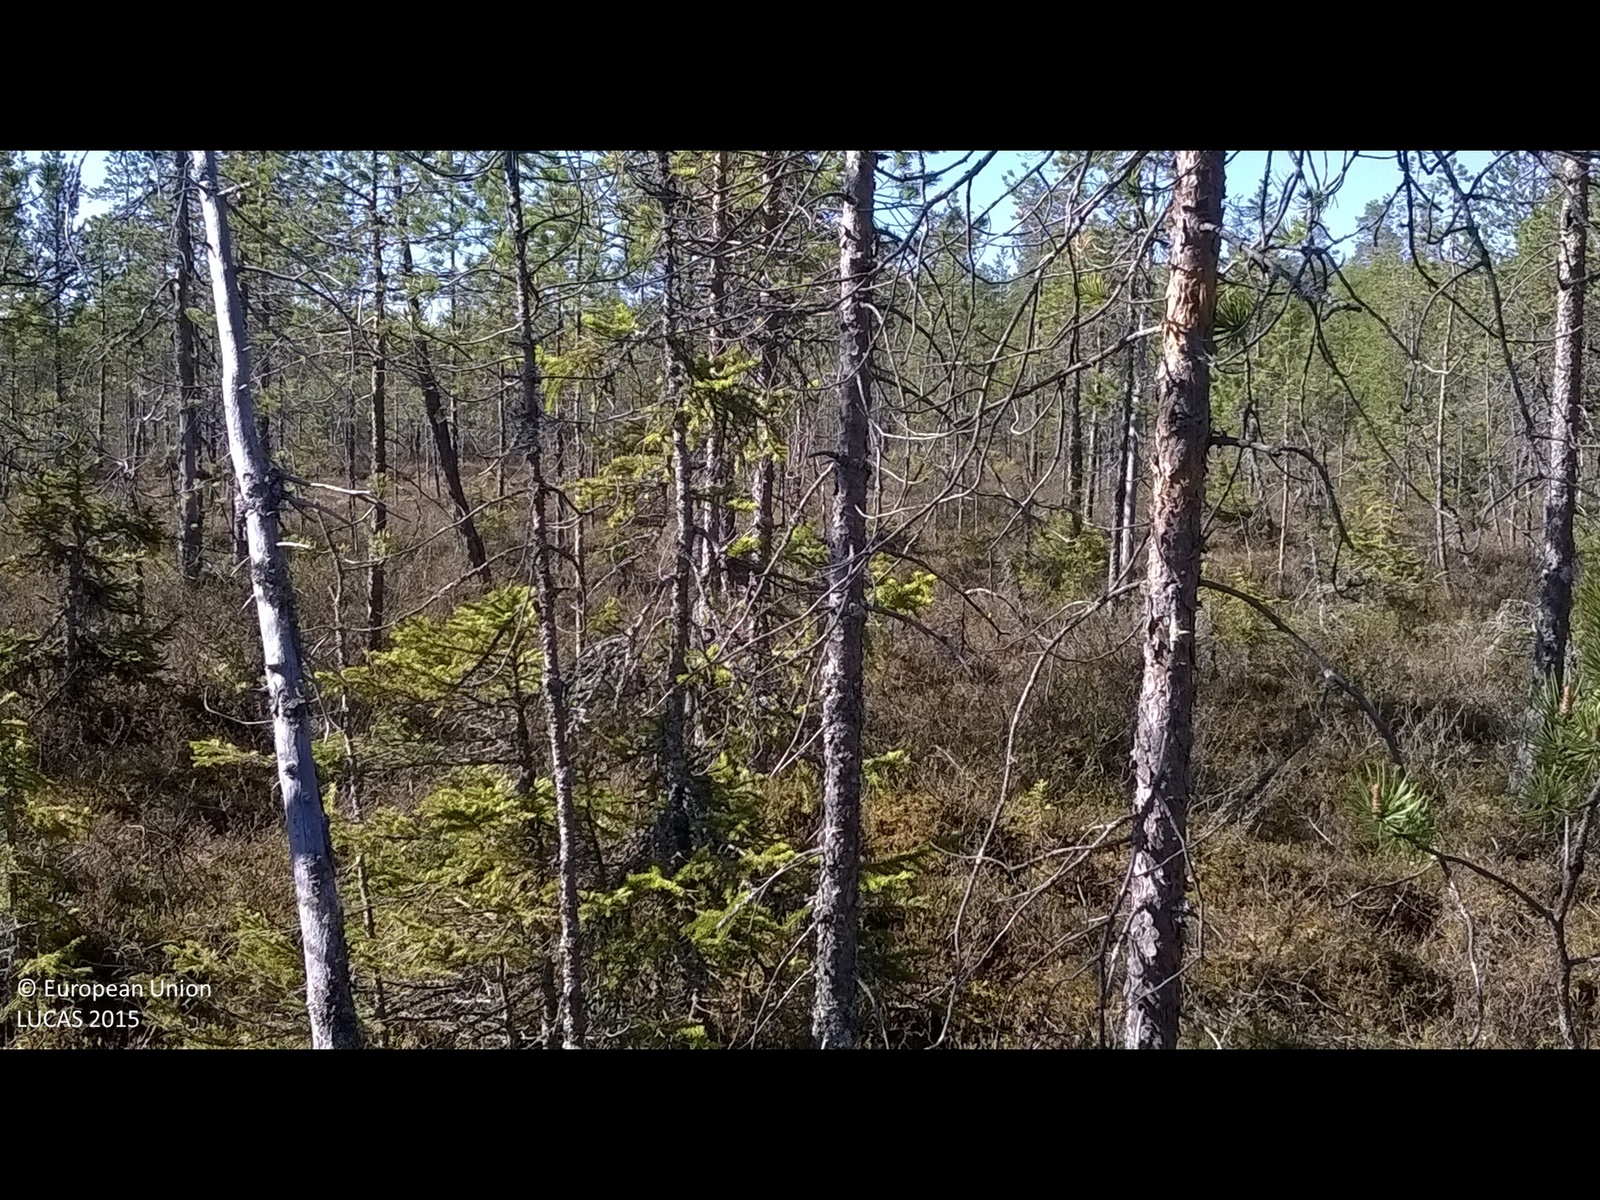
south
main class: Woodland
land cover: Pine dominated coniferous woodland
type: mire and swamp forests
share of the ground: 50 - 75 %
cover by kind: coniferous forest trees 50 %, shrubs 25 %, lichens and mosses 25 %
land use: Forestry
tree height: > 5 m
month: June
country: FI
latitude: 66.6395
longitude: 26.5622
